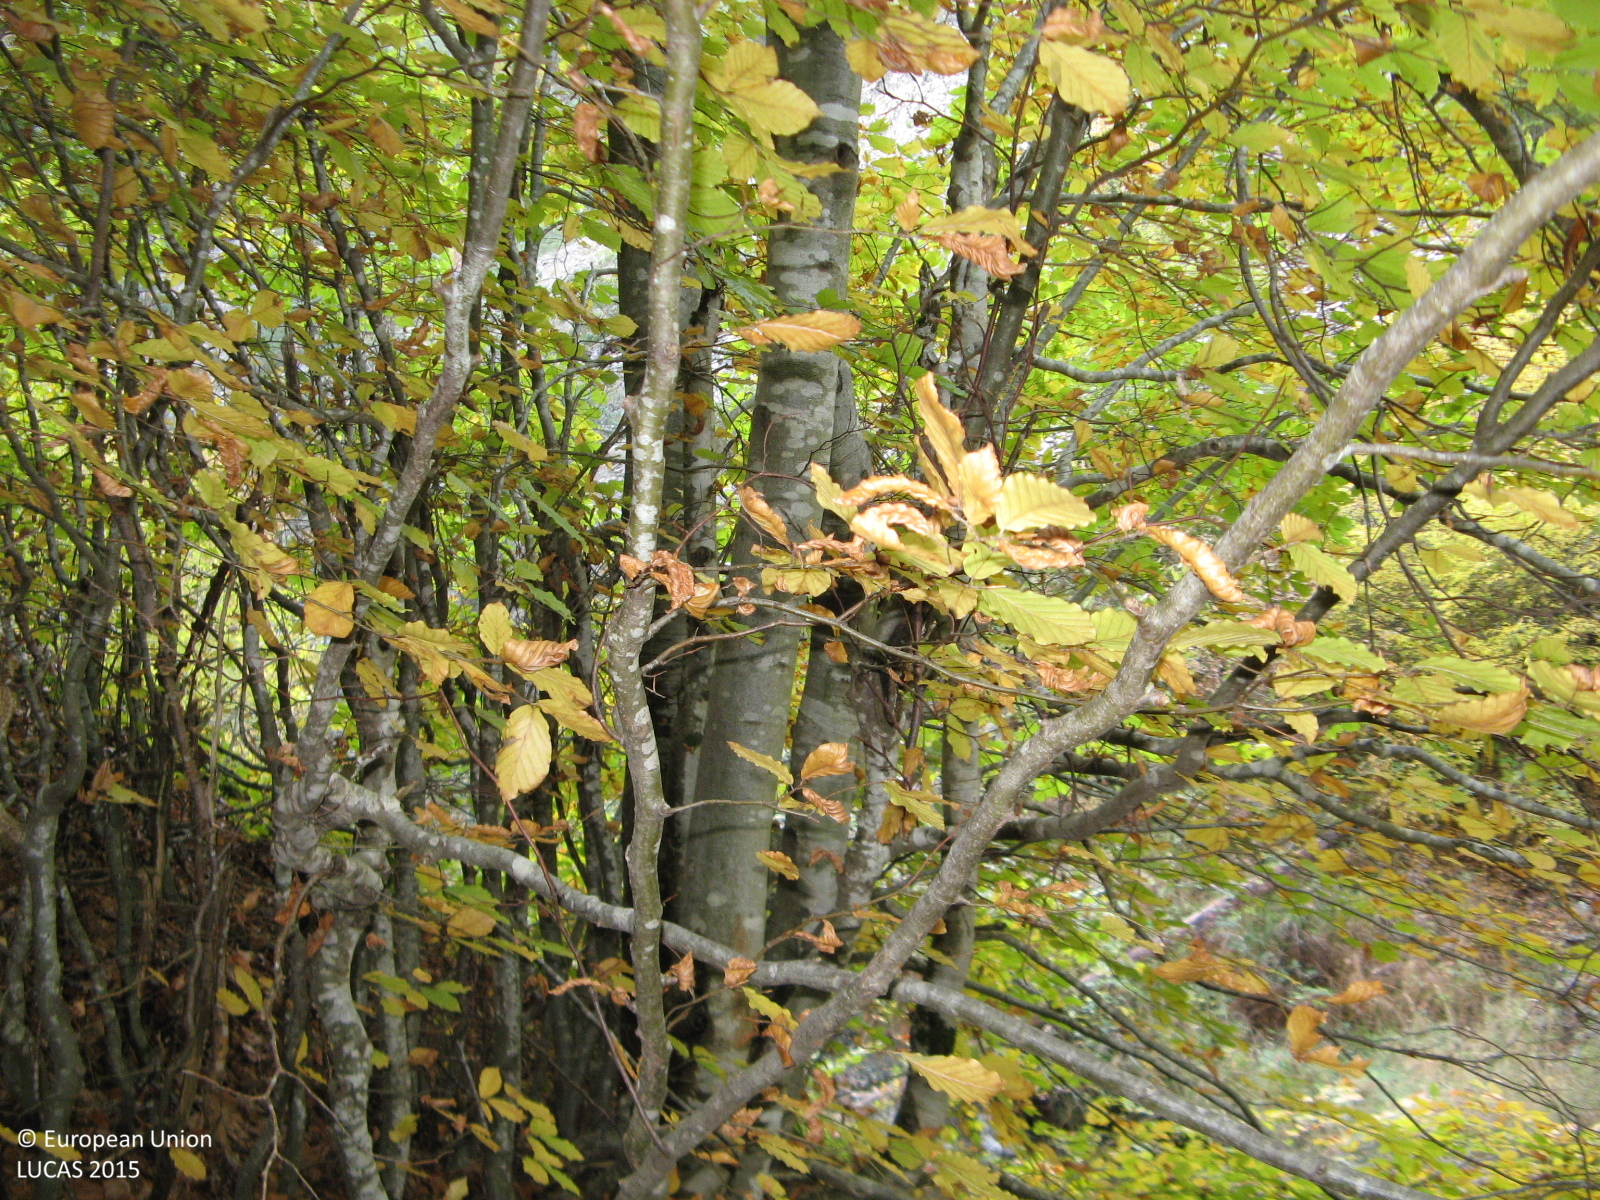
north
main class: Woodland
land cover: Broadleaved woodland
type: mountainous beech forest
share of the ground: > 75 %
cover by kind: broadleaved forest trees 95 %, unconsolidated bare surface 5 %
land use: Forestry
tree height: > 5 m
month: October
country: BG
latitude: 41.4140
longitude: 24.7945
